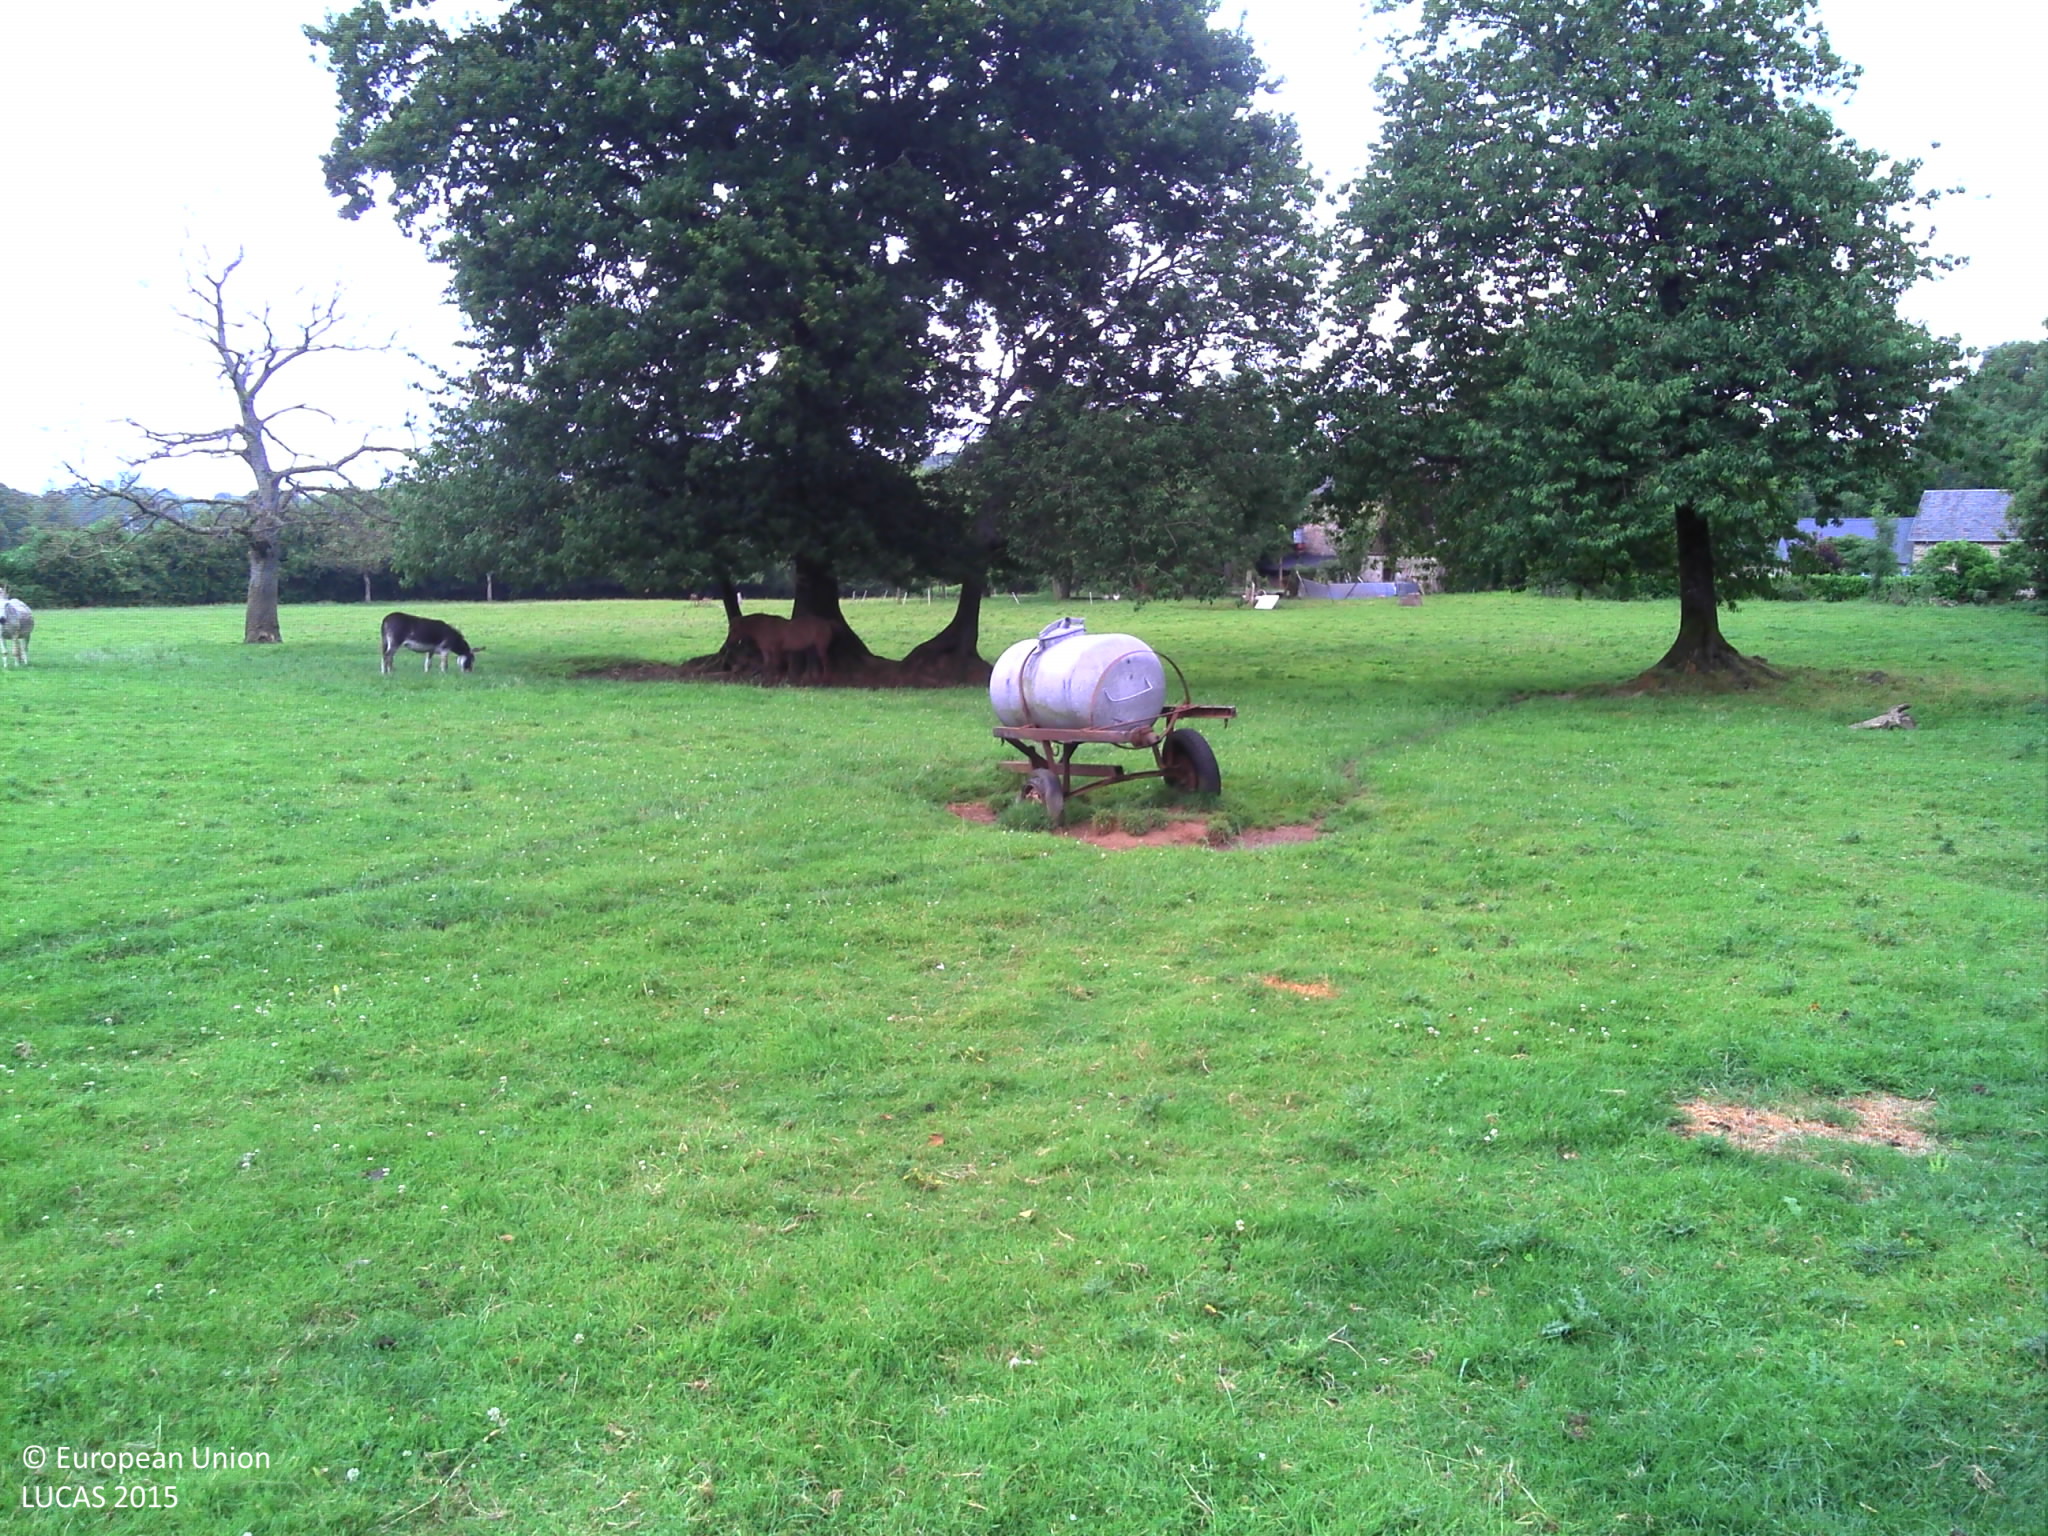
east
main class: Grassland
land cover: Grassland without tree/shrub cover
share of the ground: > 75 %
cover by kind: herbaceous plants 100 %
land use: Agriculture (excluding fallow land and kitchen gardens)
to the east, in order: Grassland without tree/shrub cover; Broadleaved woodland; Grassland without tree/shrub cover; Fences; Other fruit trees and berries; Fences; Grassland without tree/shrub cover; Electric lines; Abandoned hedges; Ditches and canals; Grass margins; Paved roads, cycling and walking lanes; Grass margins; Ditches and canals; Electric lines; Abandoned hedges; Grassland without tree/shrub cover; Broadleaved woodland; Fences; Other bare soil; Artificial constructions in urban areas
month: July
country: FR
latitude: 49.1043
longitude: -1.3748
